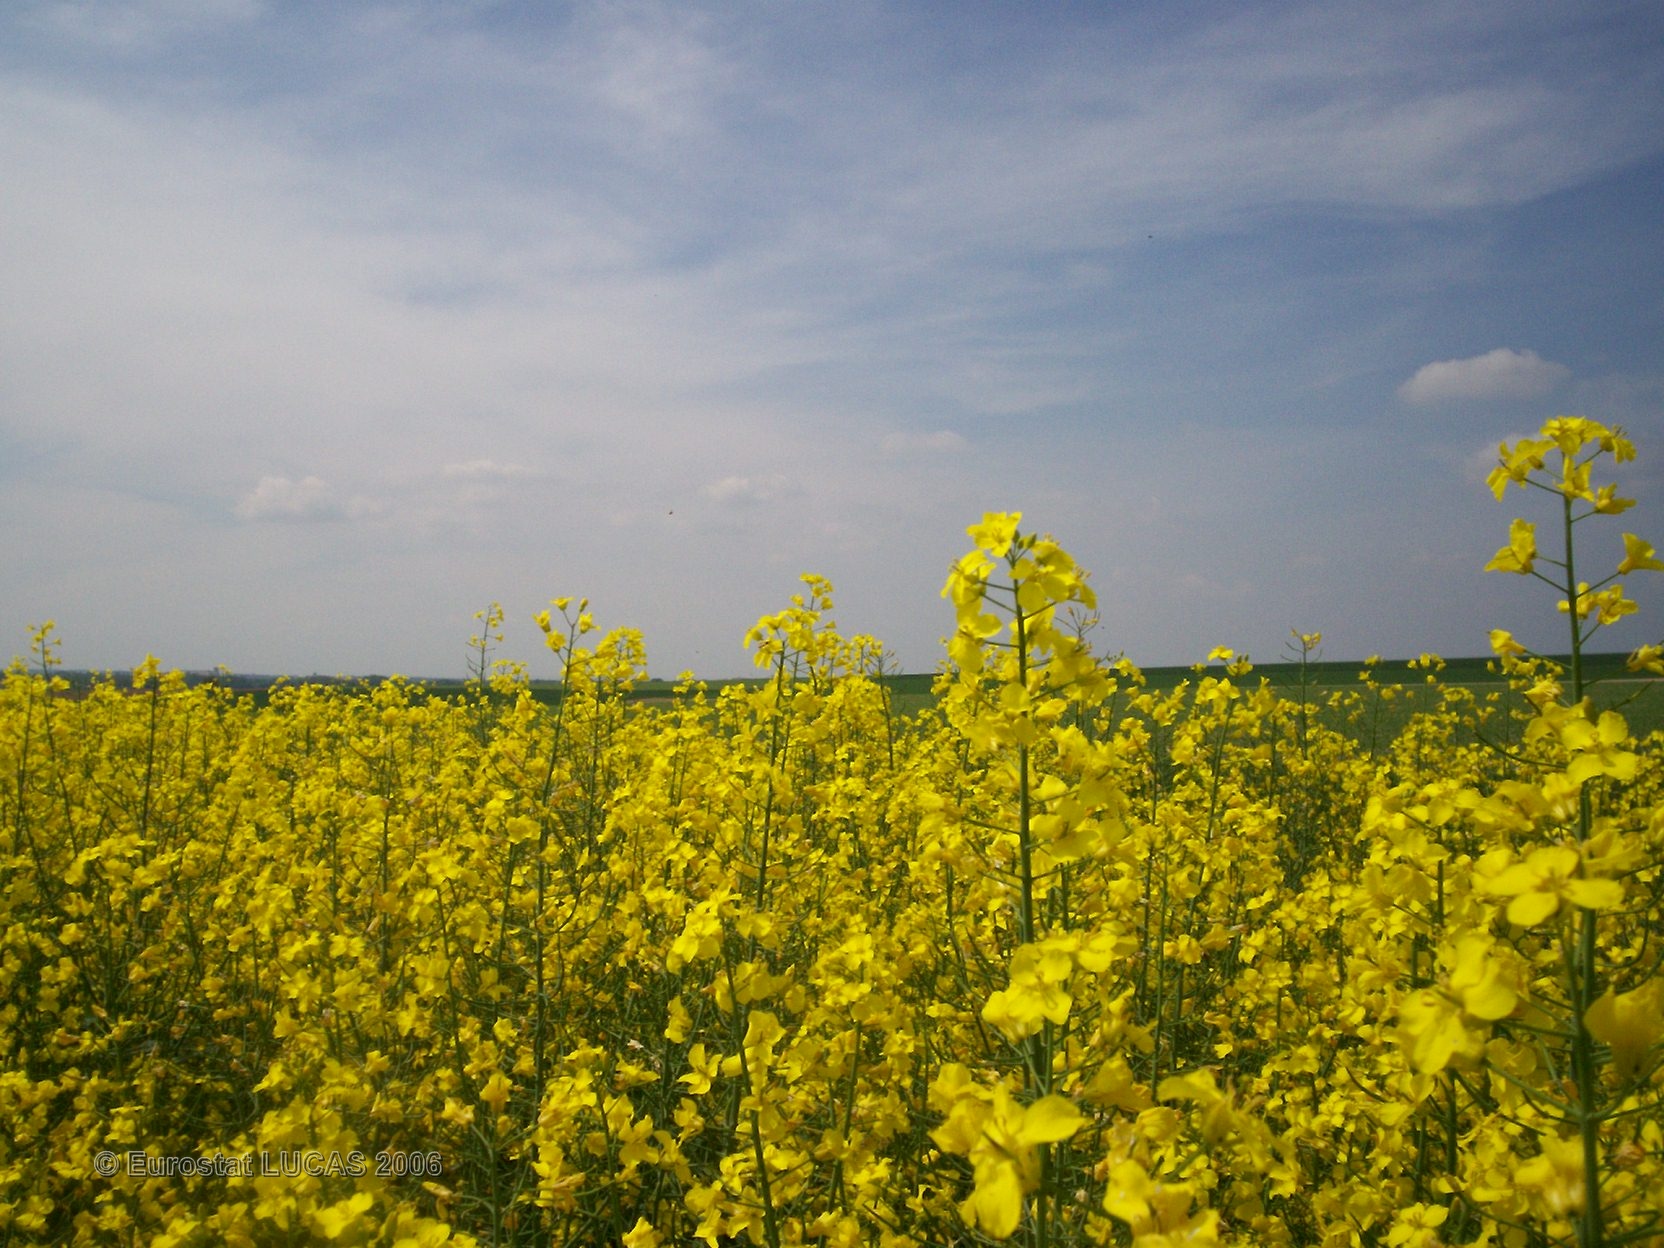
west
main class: Cropland
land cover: Rape and turnip rape
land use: Agriculture (excluding fallow land and kitchen gardens)
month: May
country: FR
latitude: 48.9309
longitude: 4.4410
